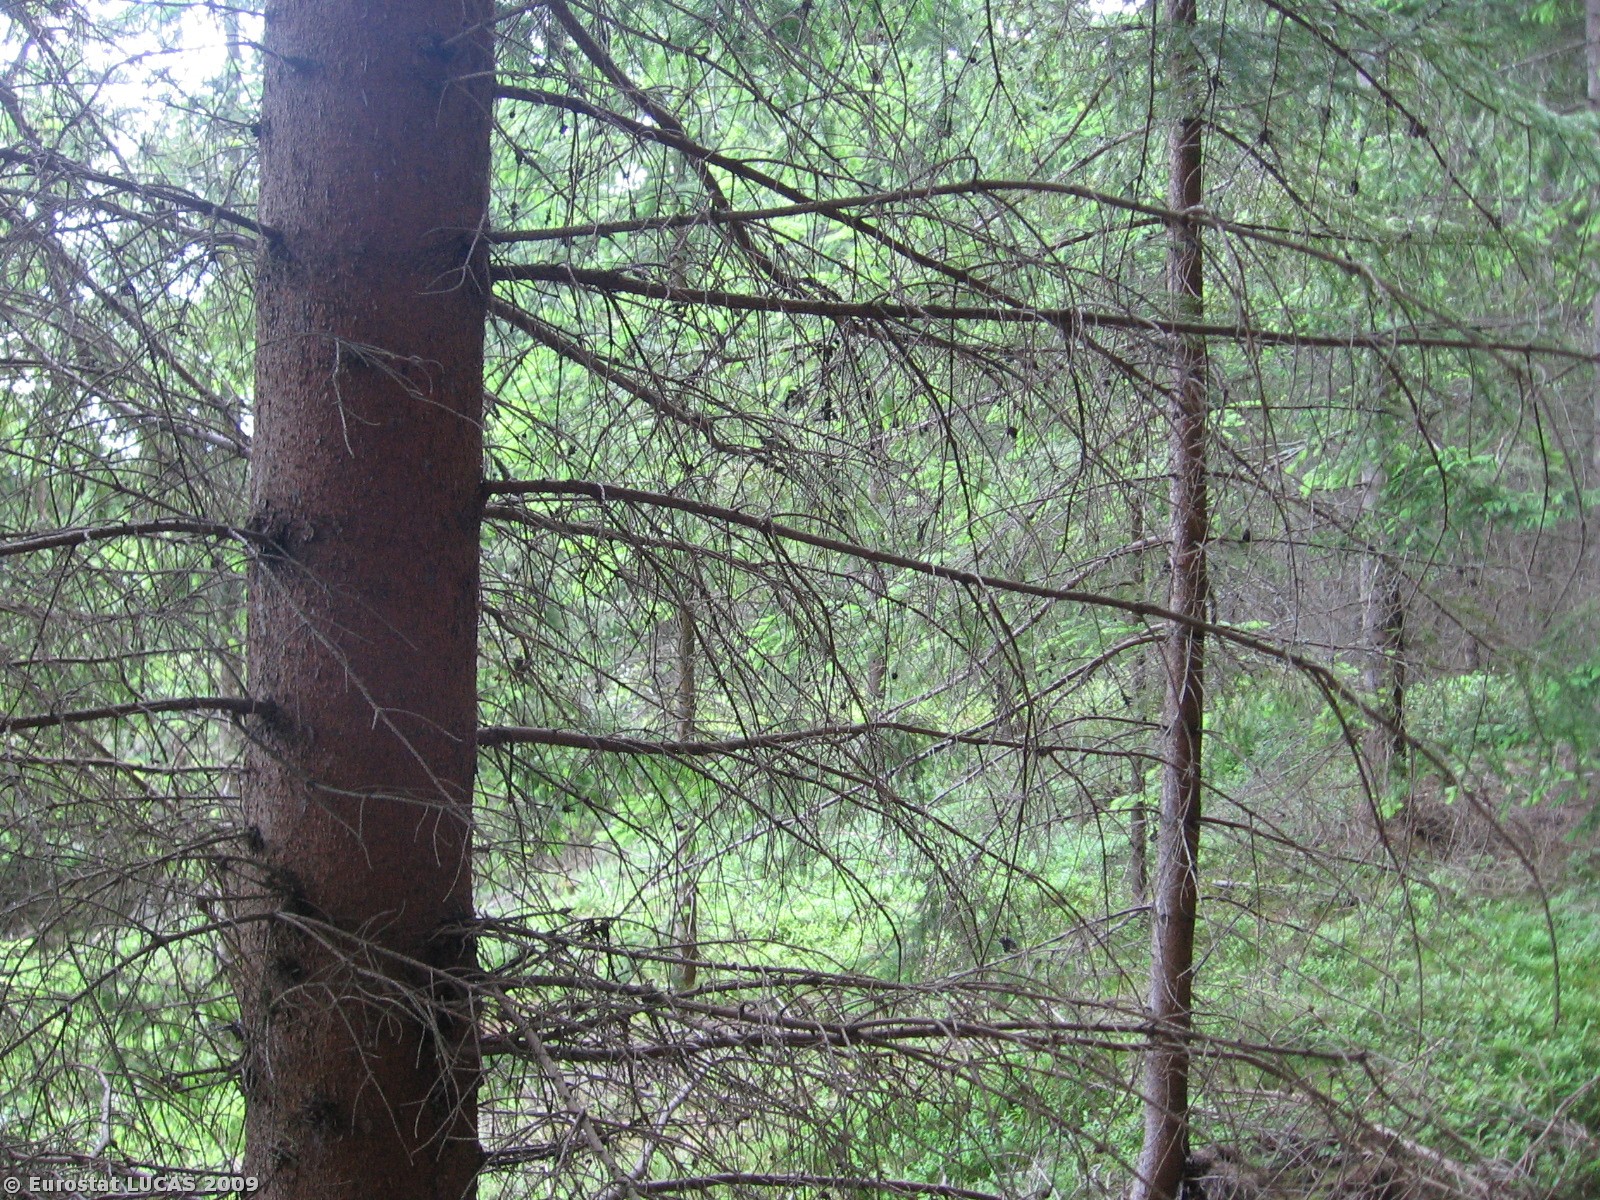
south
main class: Woodland
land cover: Coniferous woodland
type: hemiboreal forest and nemoral coniferous forest and mixed broadleaved-coniferous forest
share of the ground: > 75 %
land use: Forestry
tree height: > 5 m
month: June
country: CZ
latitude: 49.0571
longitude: 13.8456
